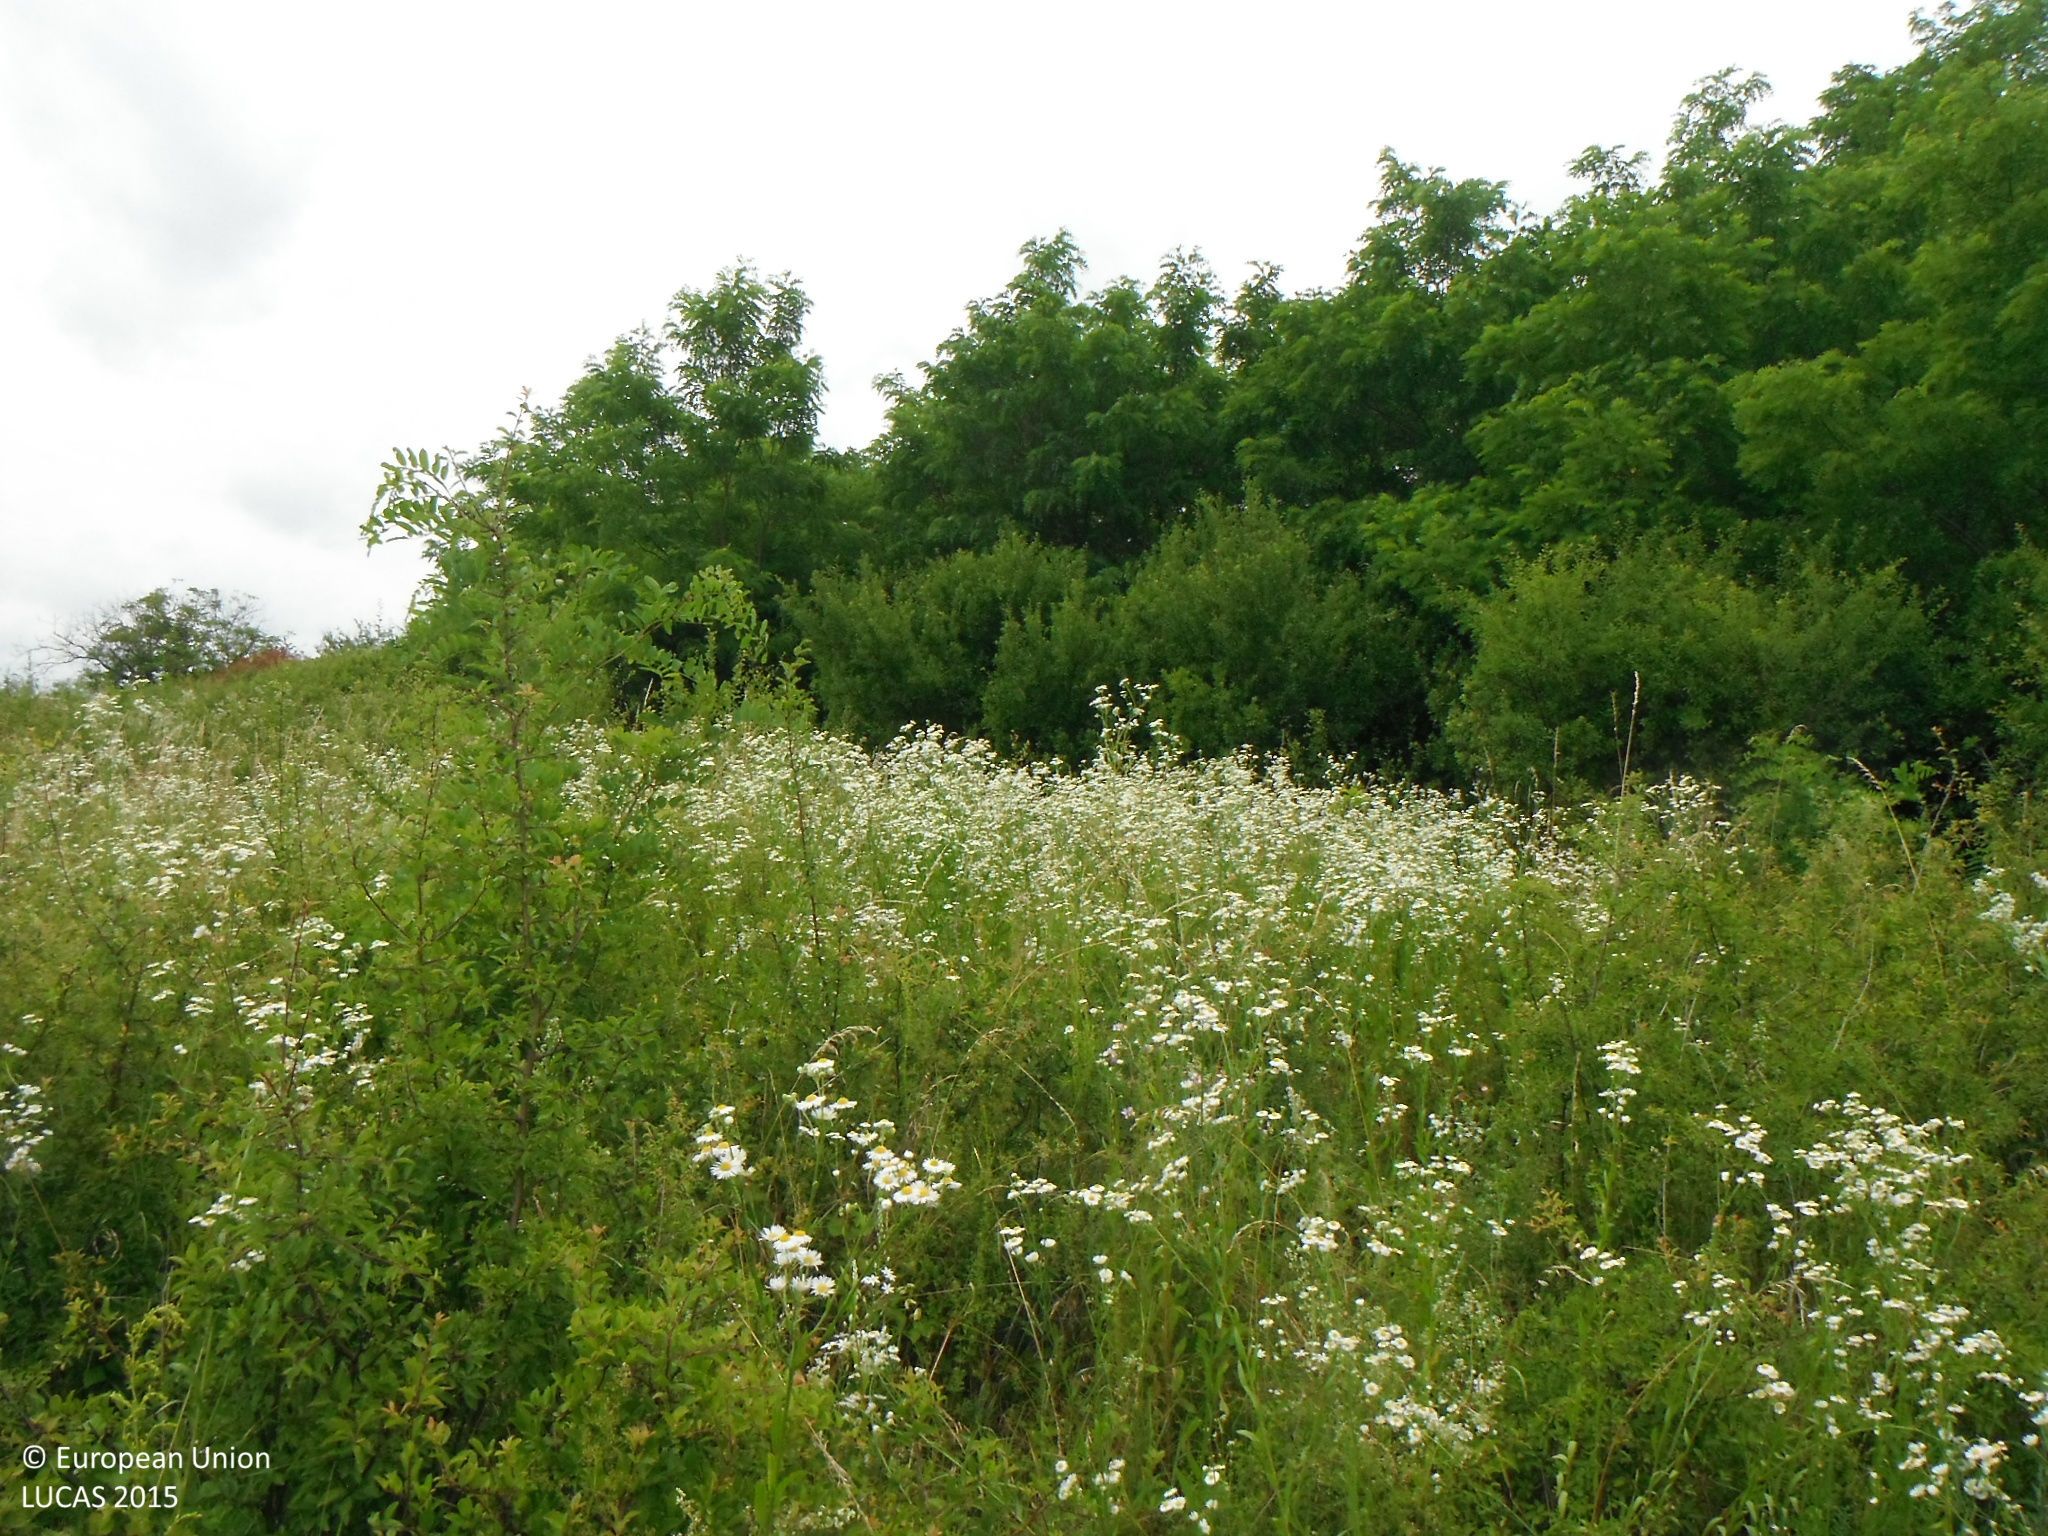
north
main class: Shrubland
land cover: Shrubland without tree cover
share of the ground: > 75 %
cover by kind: shrubs 90 %, herbaceous plants 10 %
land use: Semi-natural and natural areas not in use
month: June
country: SK
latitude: 48.1410
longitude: 19.4713
